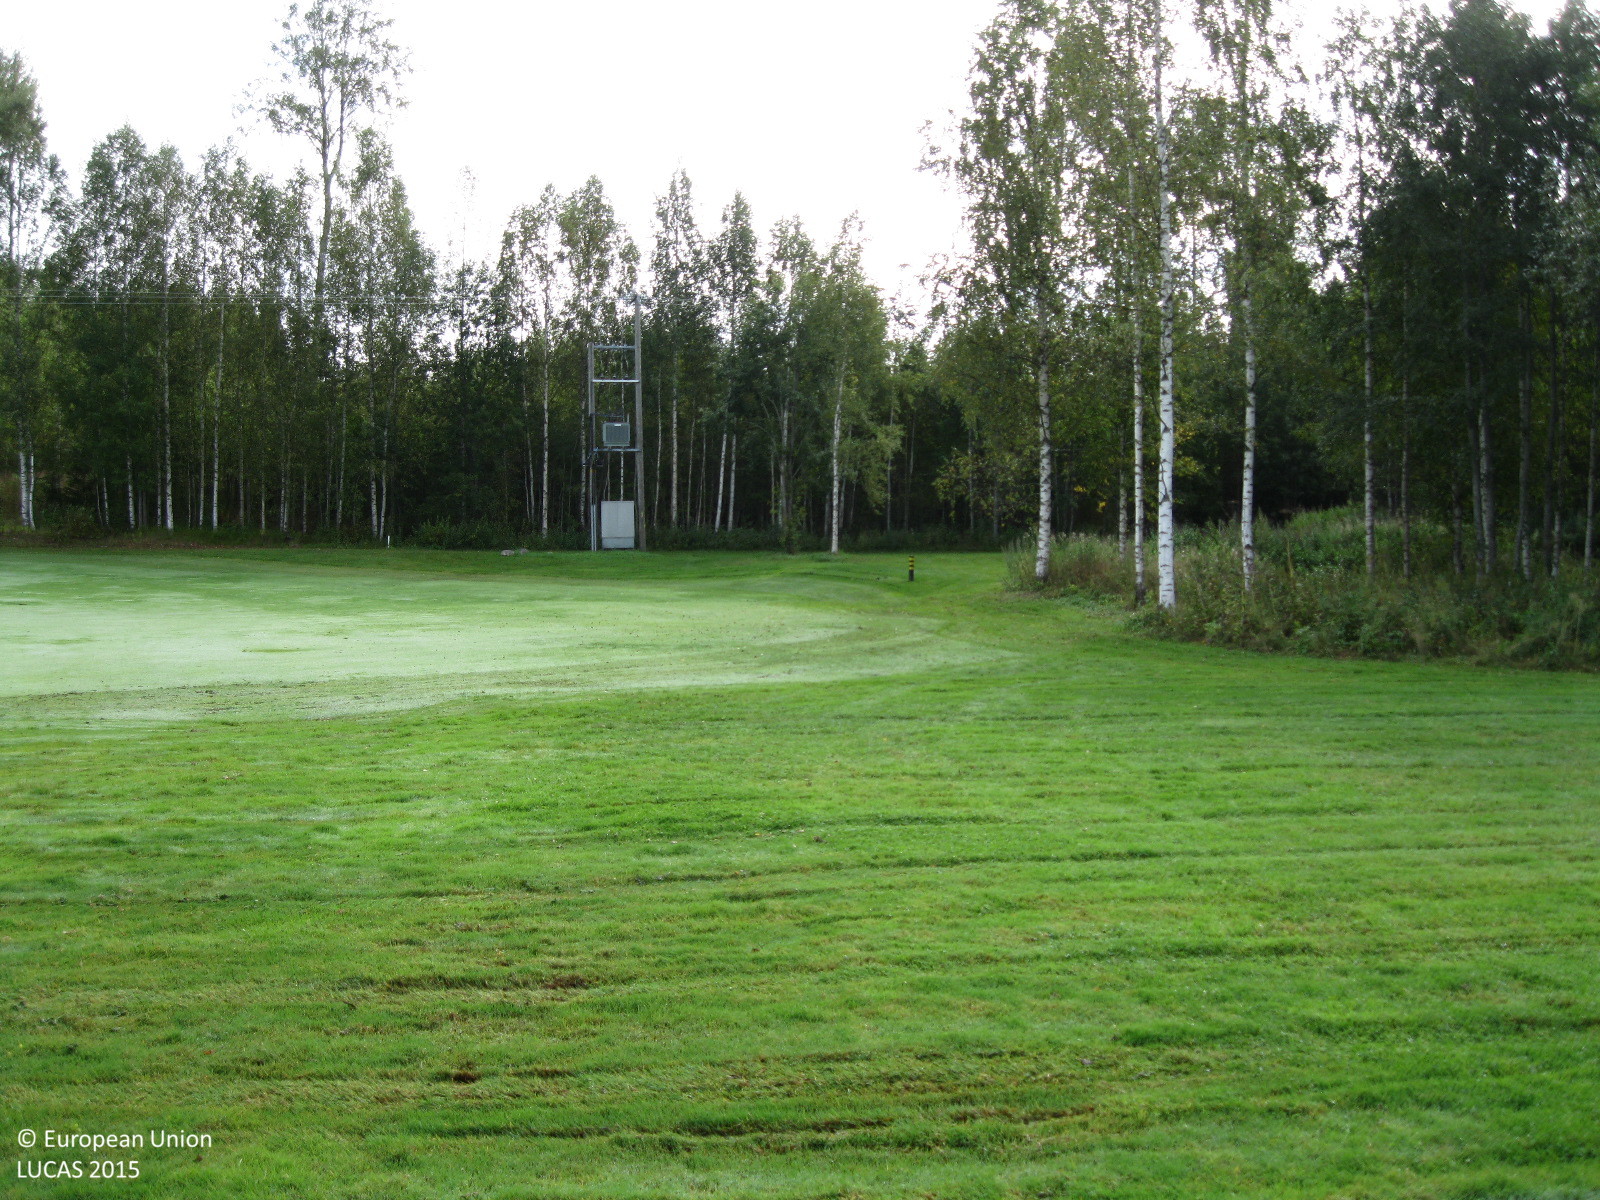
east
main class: Grassland
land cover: Grassland without tree/shrub cover
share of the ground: > 75 %
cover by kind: herbaceous plants 100 %
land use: Sport
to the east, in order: Grassland without tree/shrub cover; Electric lines; Grassland without tree/shrub cover; Grass margins; Ditches and canals; Broadleaved woodland; Spruce dominated mixed woodland; Broadleaved woodland
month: September
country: FI
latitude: 60.5001
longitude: 24.5815
